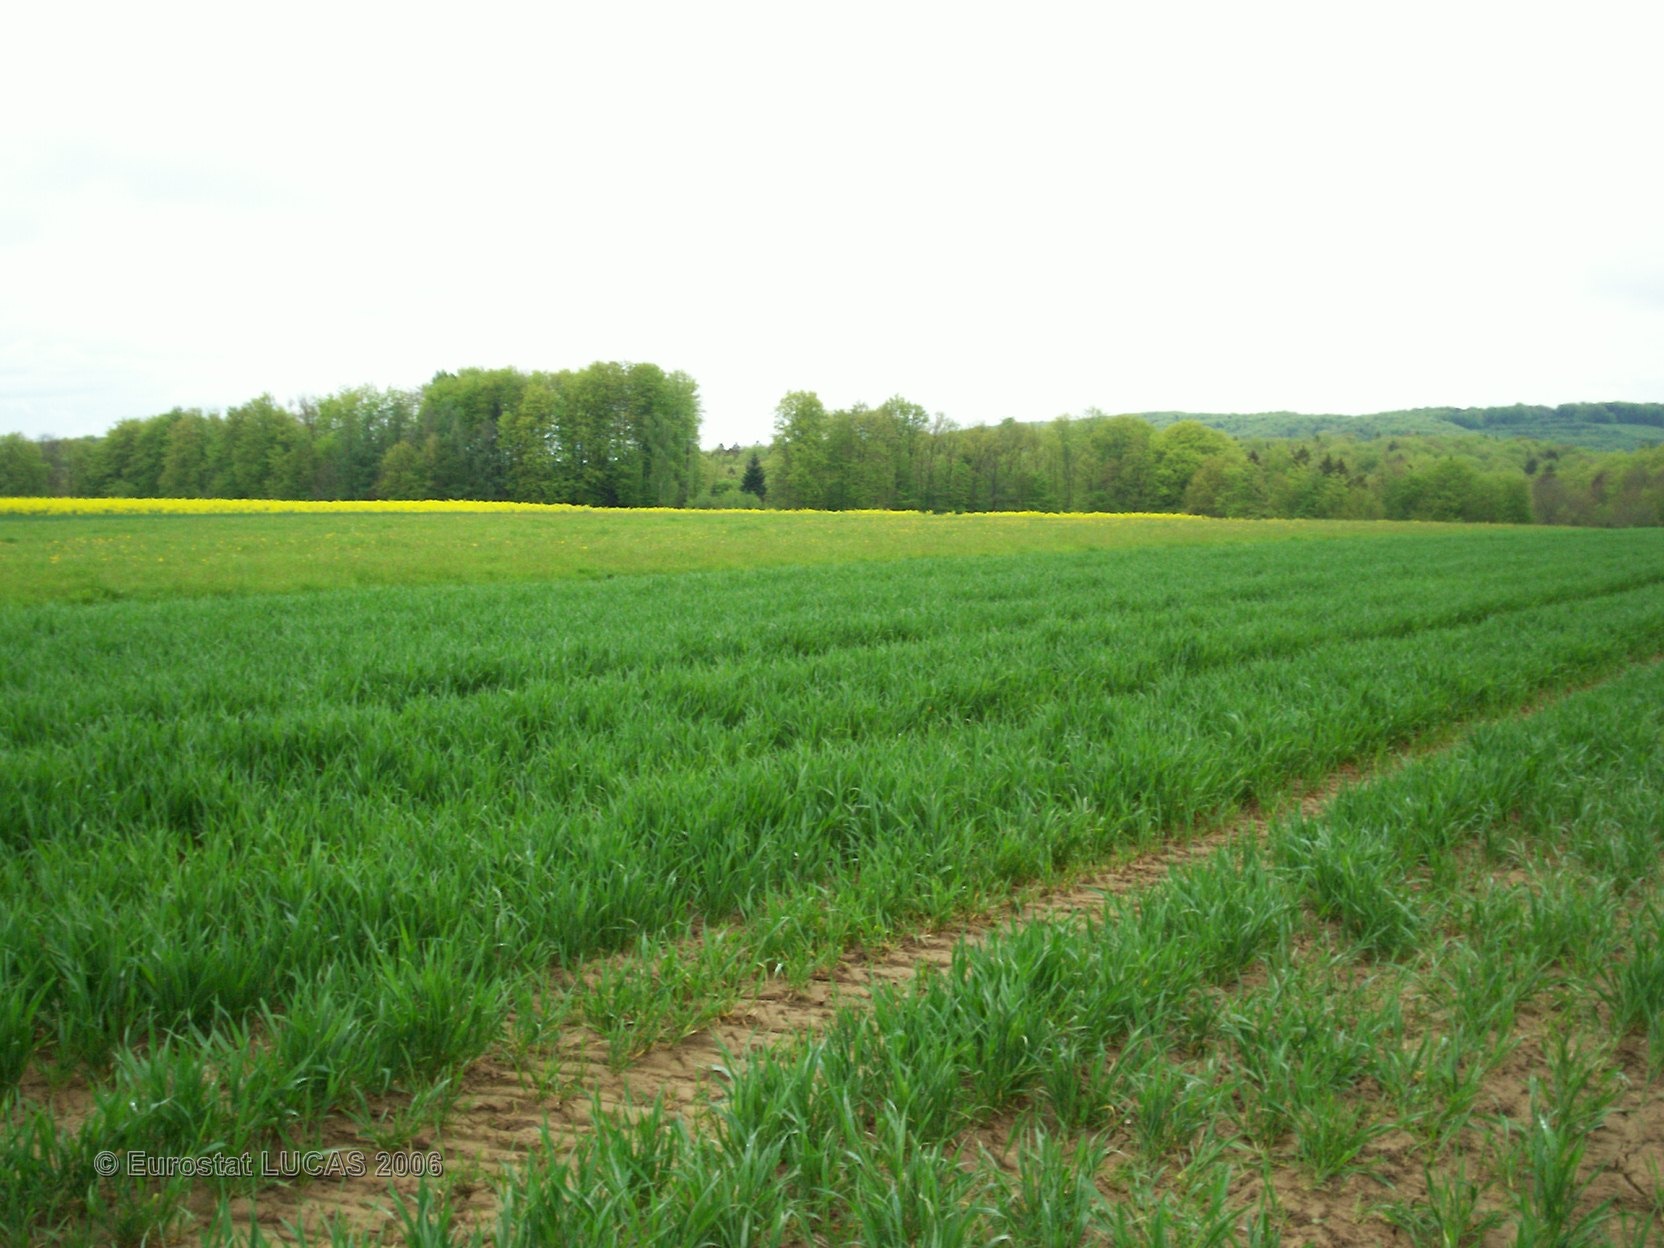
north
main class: Cropland
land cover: Common wheat
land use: Agriculture (excluding fallow land and kitchen gardens)
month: May
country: FR
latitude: 48.1086
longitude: 6.3341
